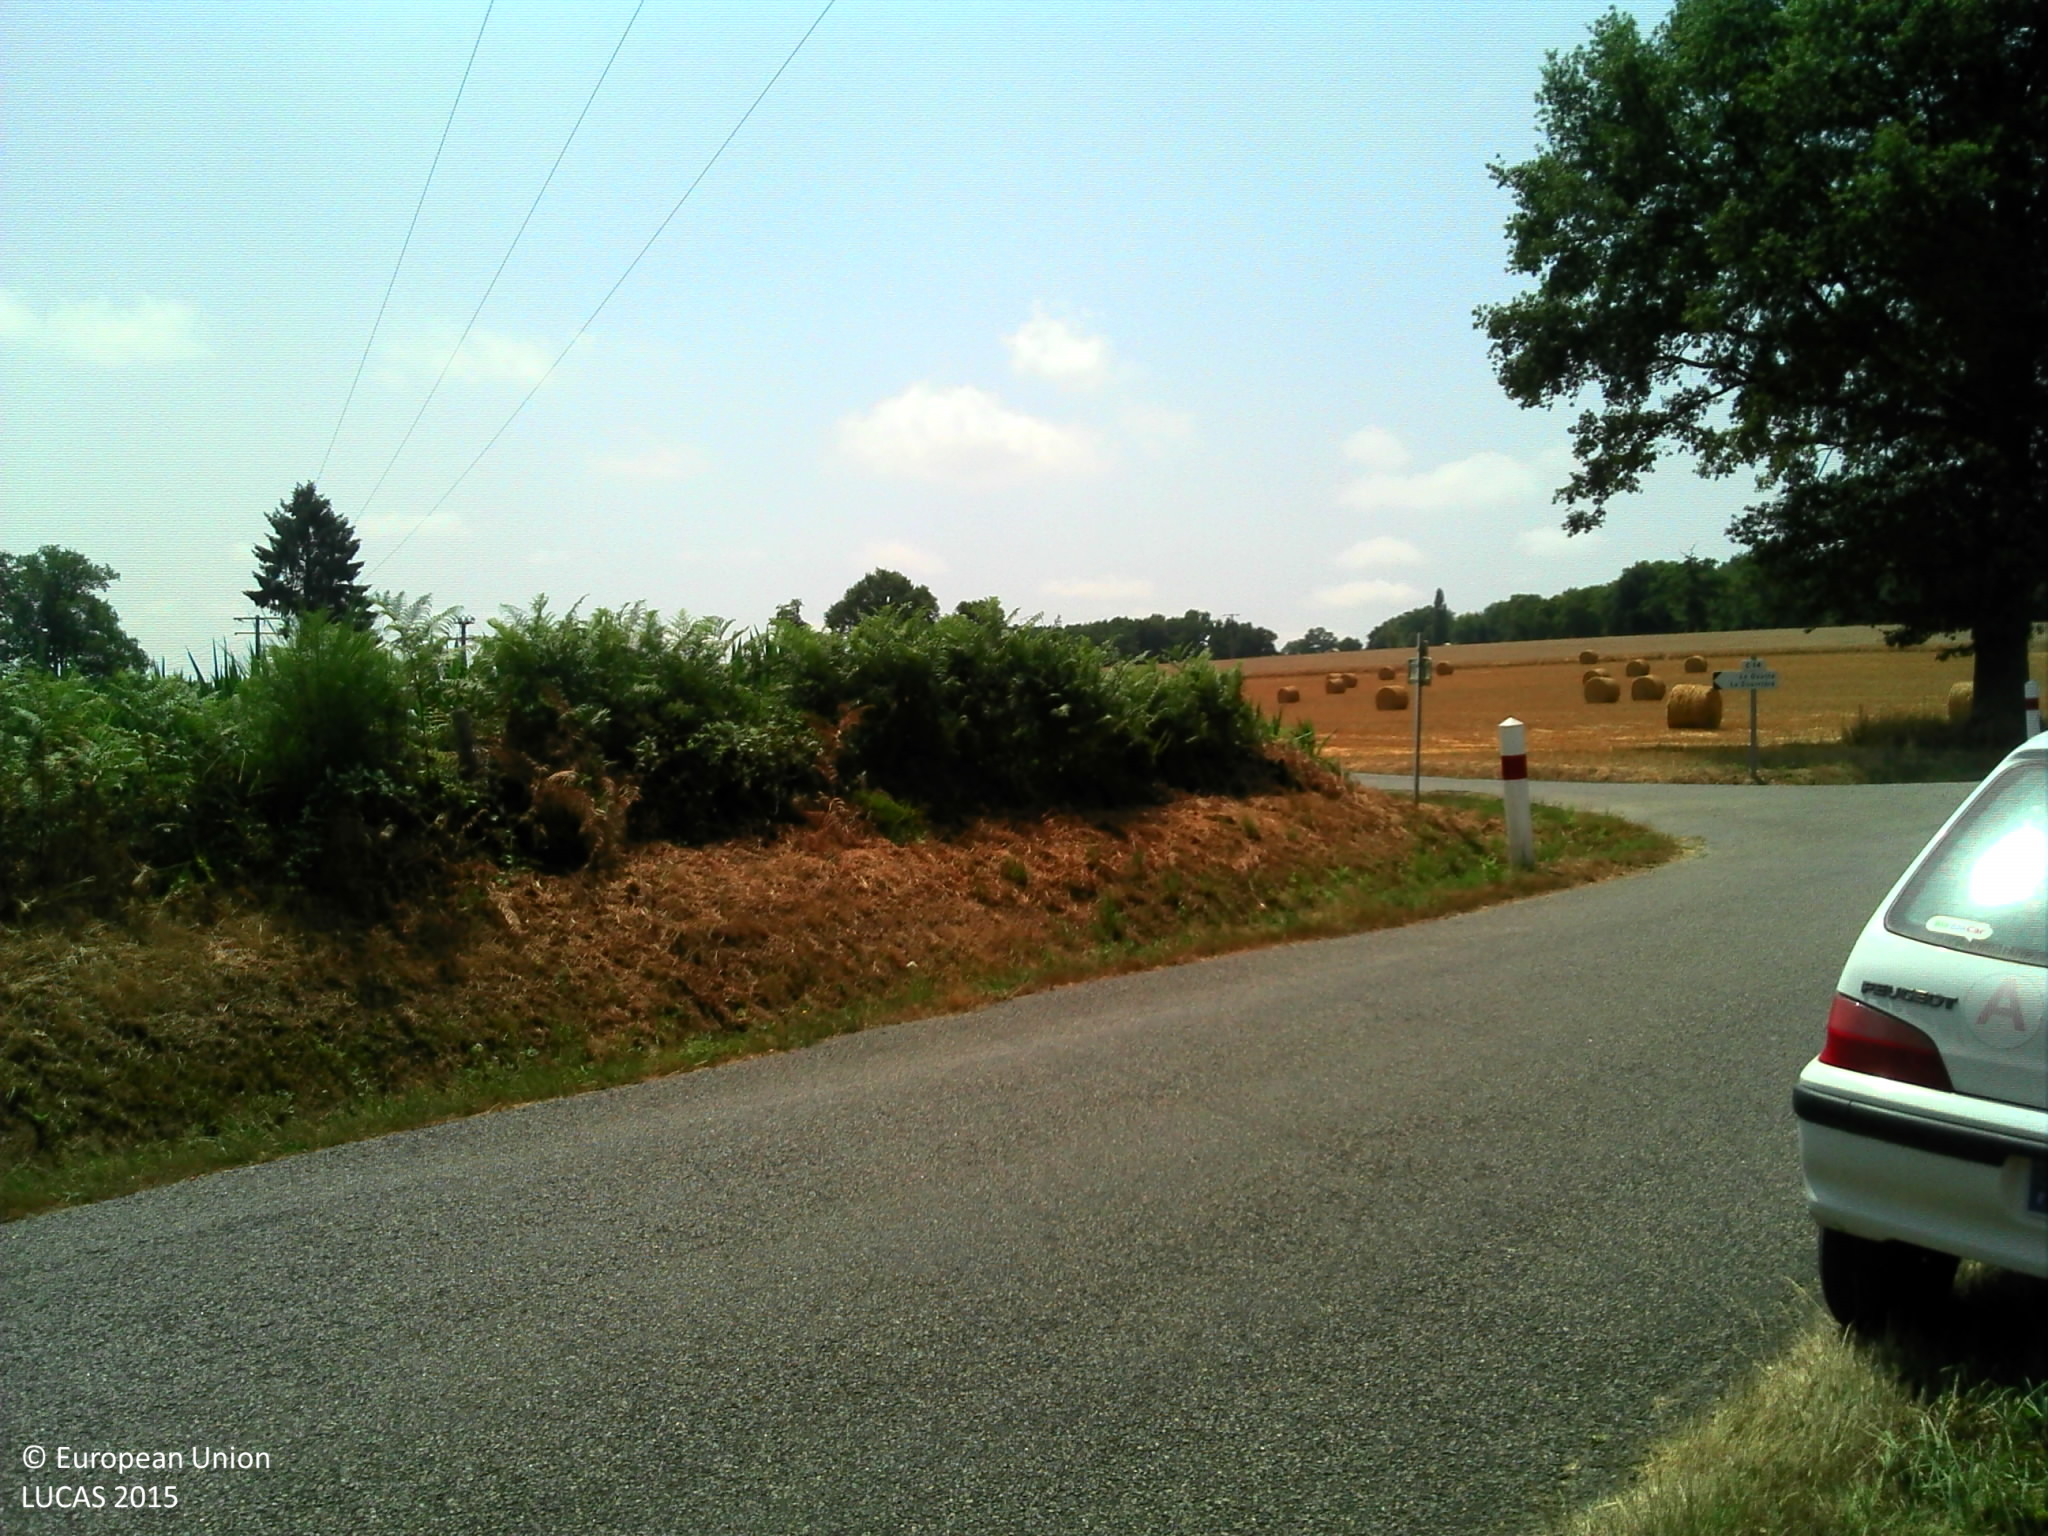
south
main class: Grassland
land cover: Grassland without tree/shrub cover
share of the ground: > 75 %
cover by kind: herbaceous plants 95 %
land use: Agriculture (excluding fallow land and kitchen gardens)
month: July
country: FR
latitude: 45.7340
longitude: 0.9809
